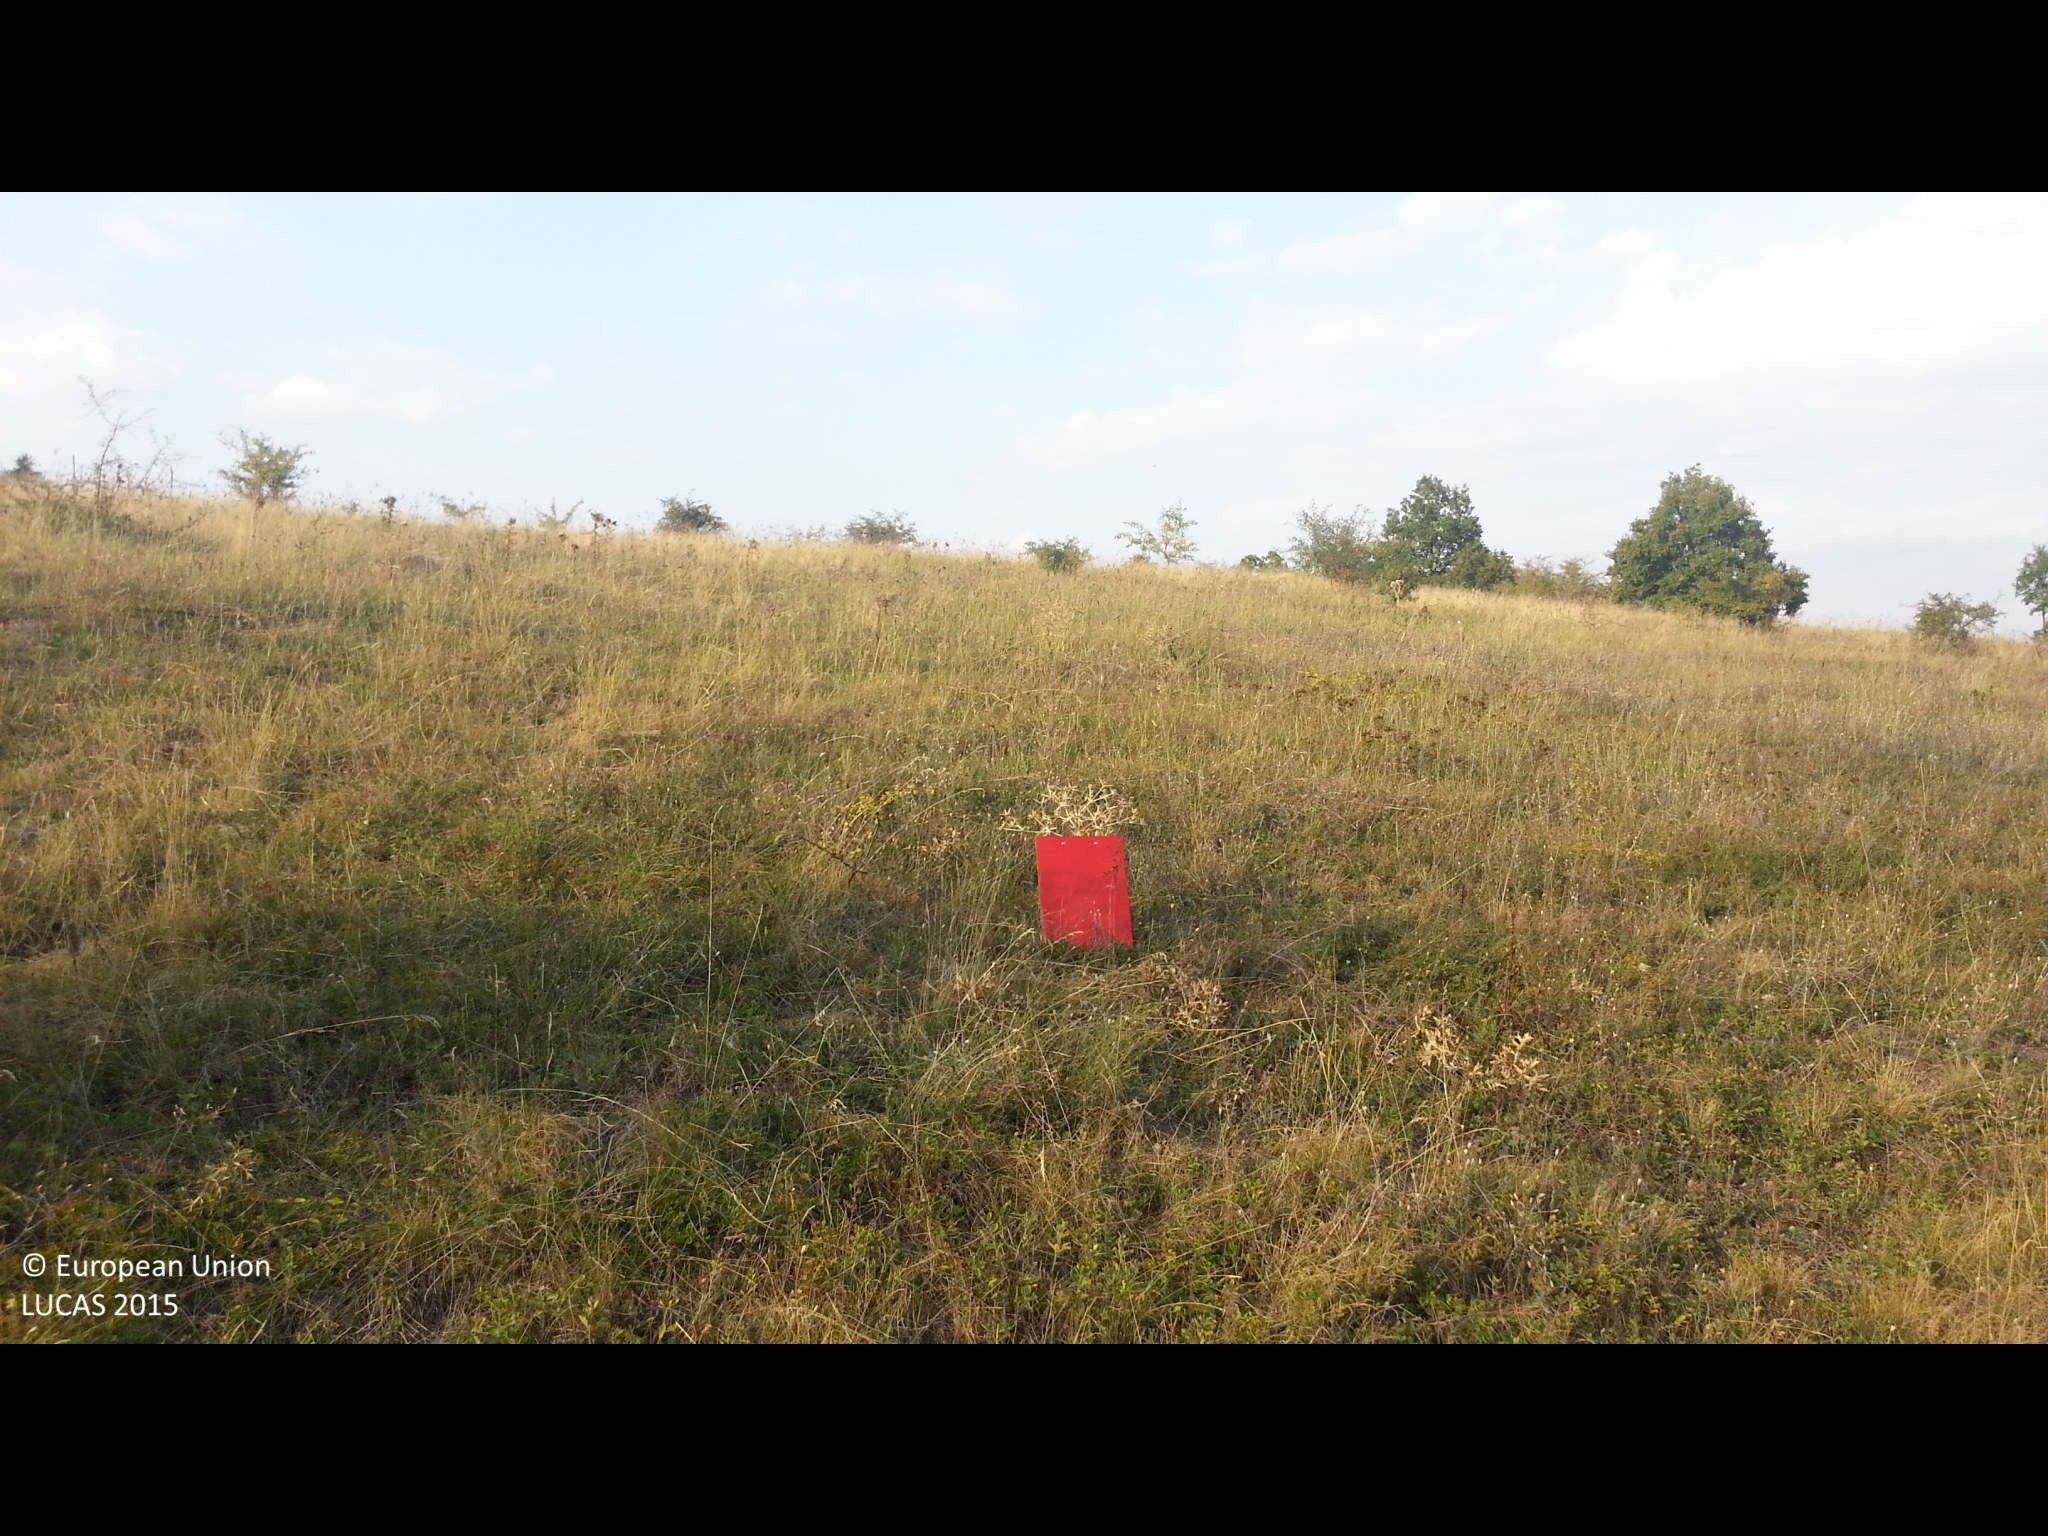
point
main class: Grassland
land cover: Grassland with sparse tree/shrub cover
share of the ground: > 75 %
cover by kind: herbaceous plants 90 %, broadleaved forest trees 5 %, shrubs 5 %
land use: Agriculture (excluding fallow land and kitchen gardens)
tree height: < 5 m
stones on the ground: < 10 %
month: September
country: BG
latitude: 42.5487
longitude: 23.0966
